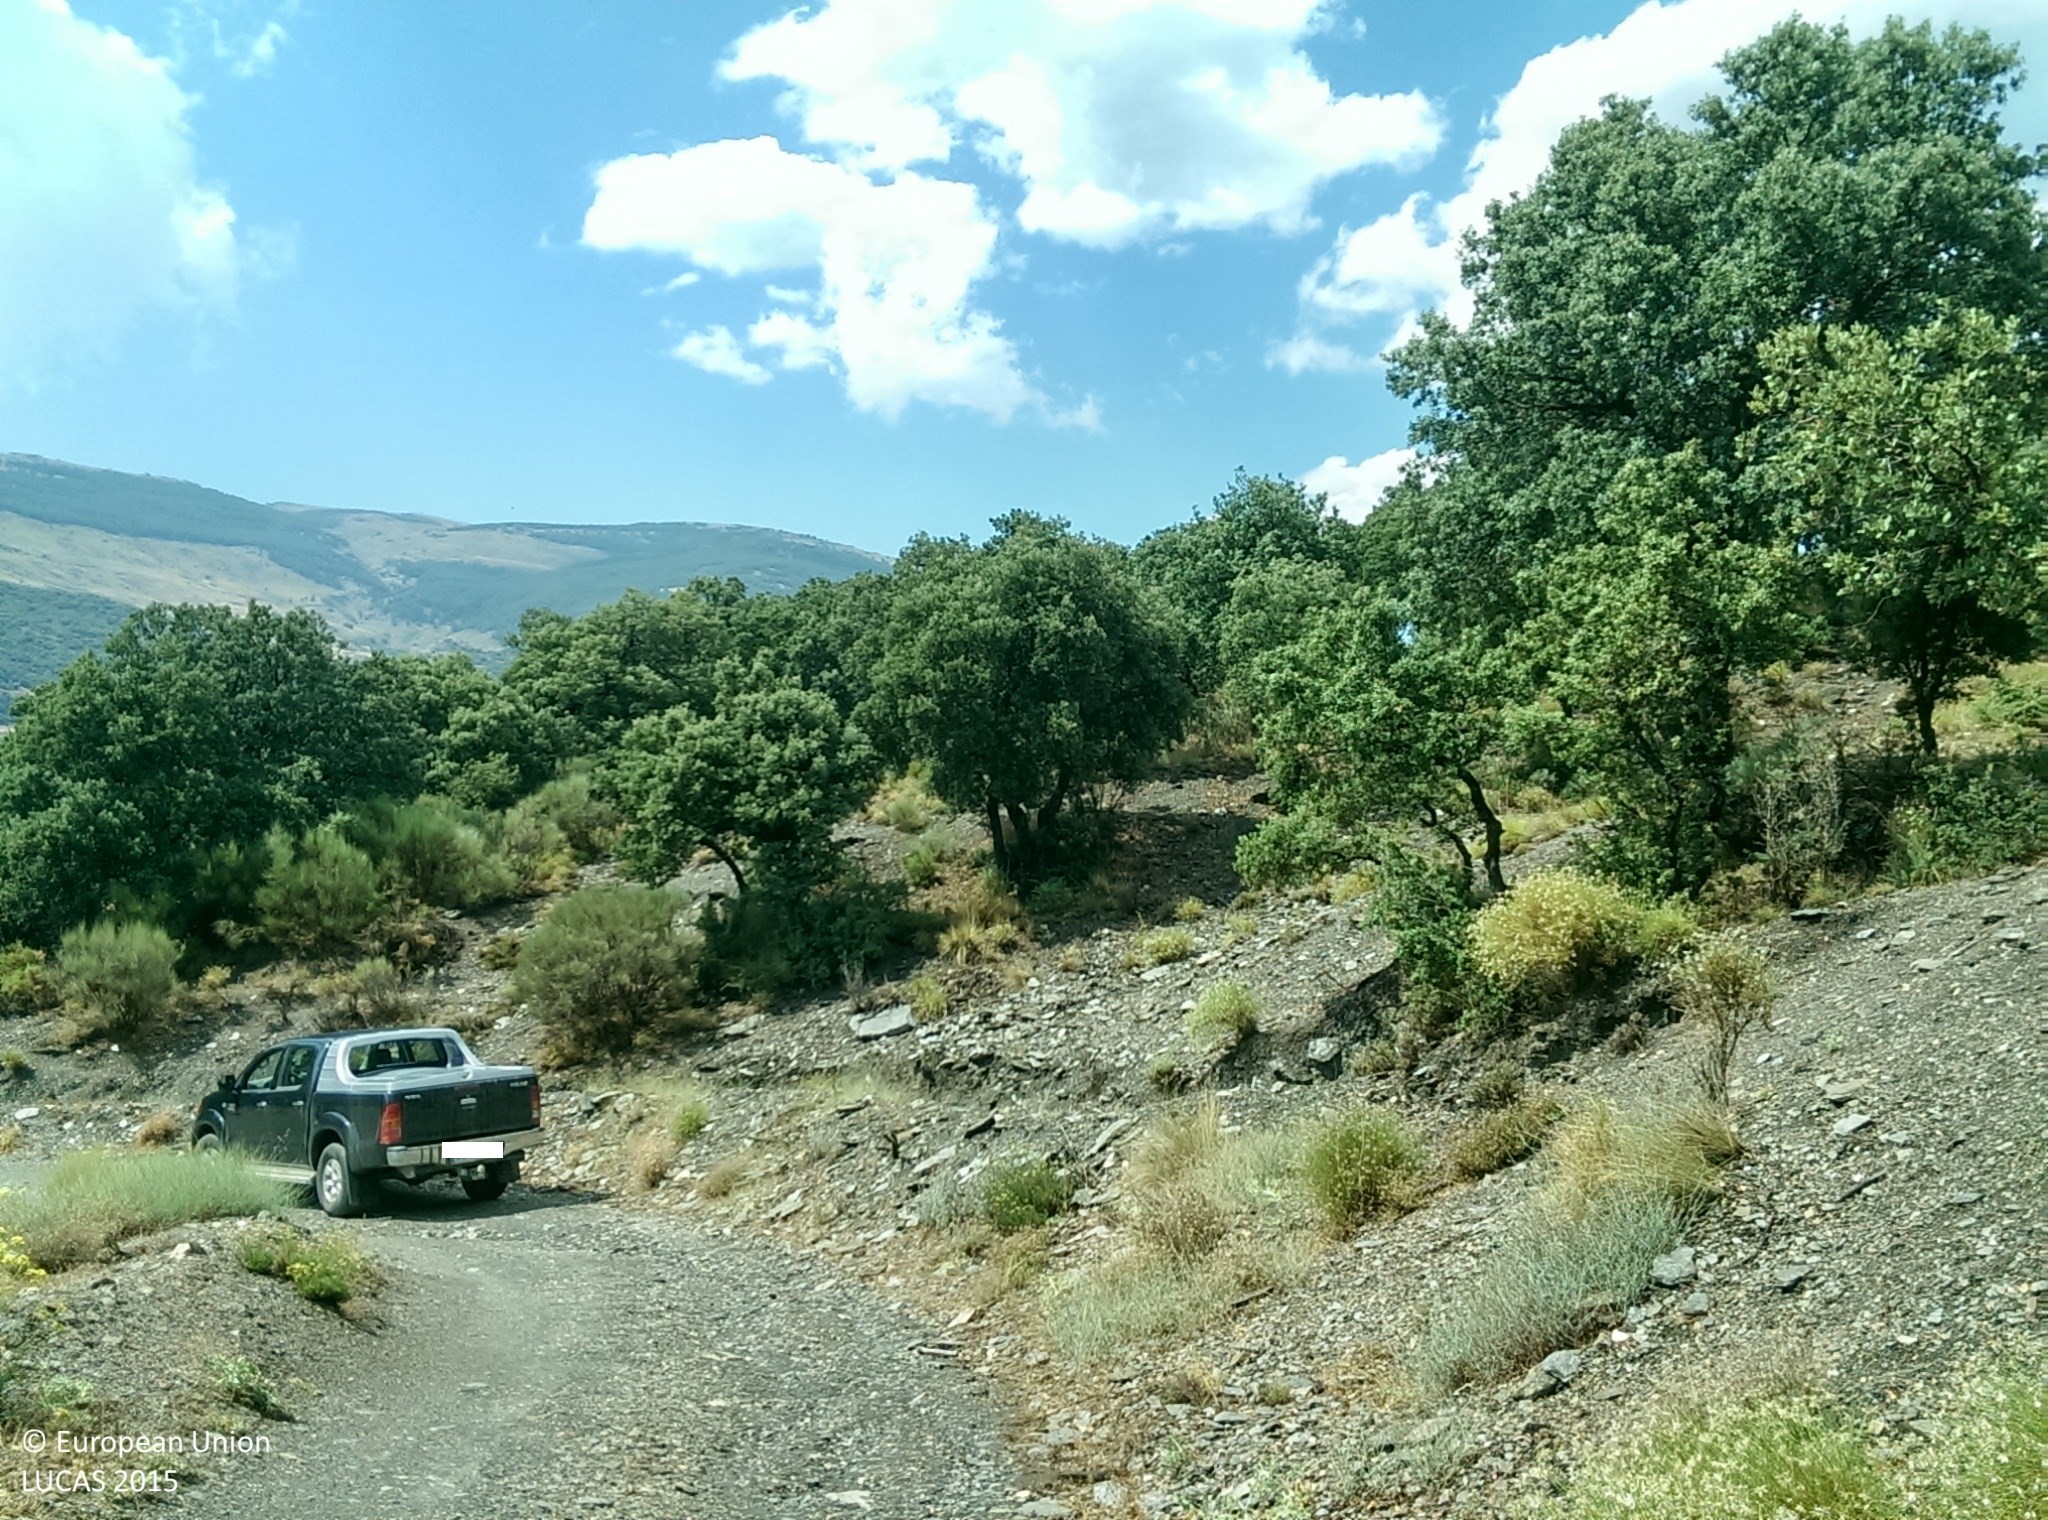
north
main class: Woodland
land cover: Broadleaved woodland
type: broadleaved evergreen forest
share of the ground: 50 - 75 %
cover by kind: broadleaved forest trees 65 %, shrubs 15 %, herbaceous plants 15 %, unconsolidated bare surface 5 %
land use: Forestry
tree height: > 5 m
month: July
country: ES
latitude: 37.0145
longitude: -3.1437
